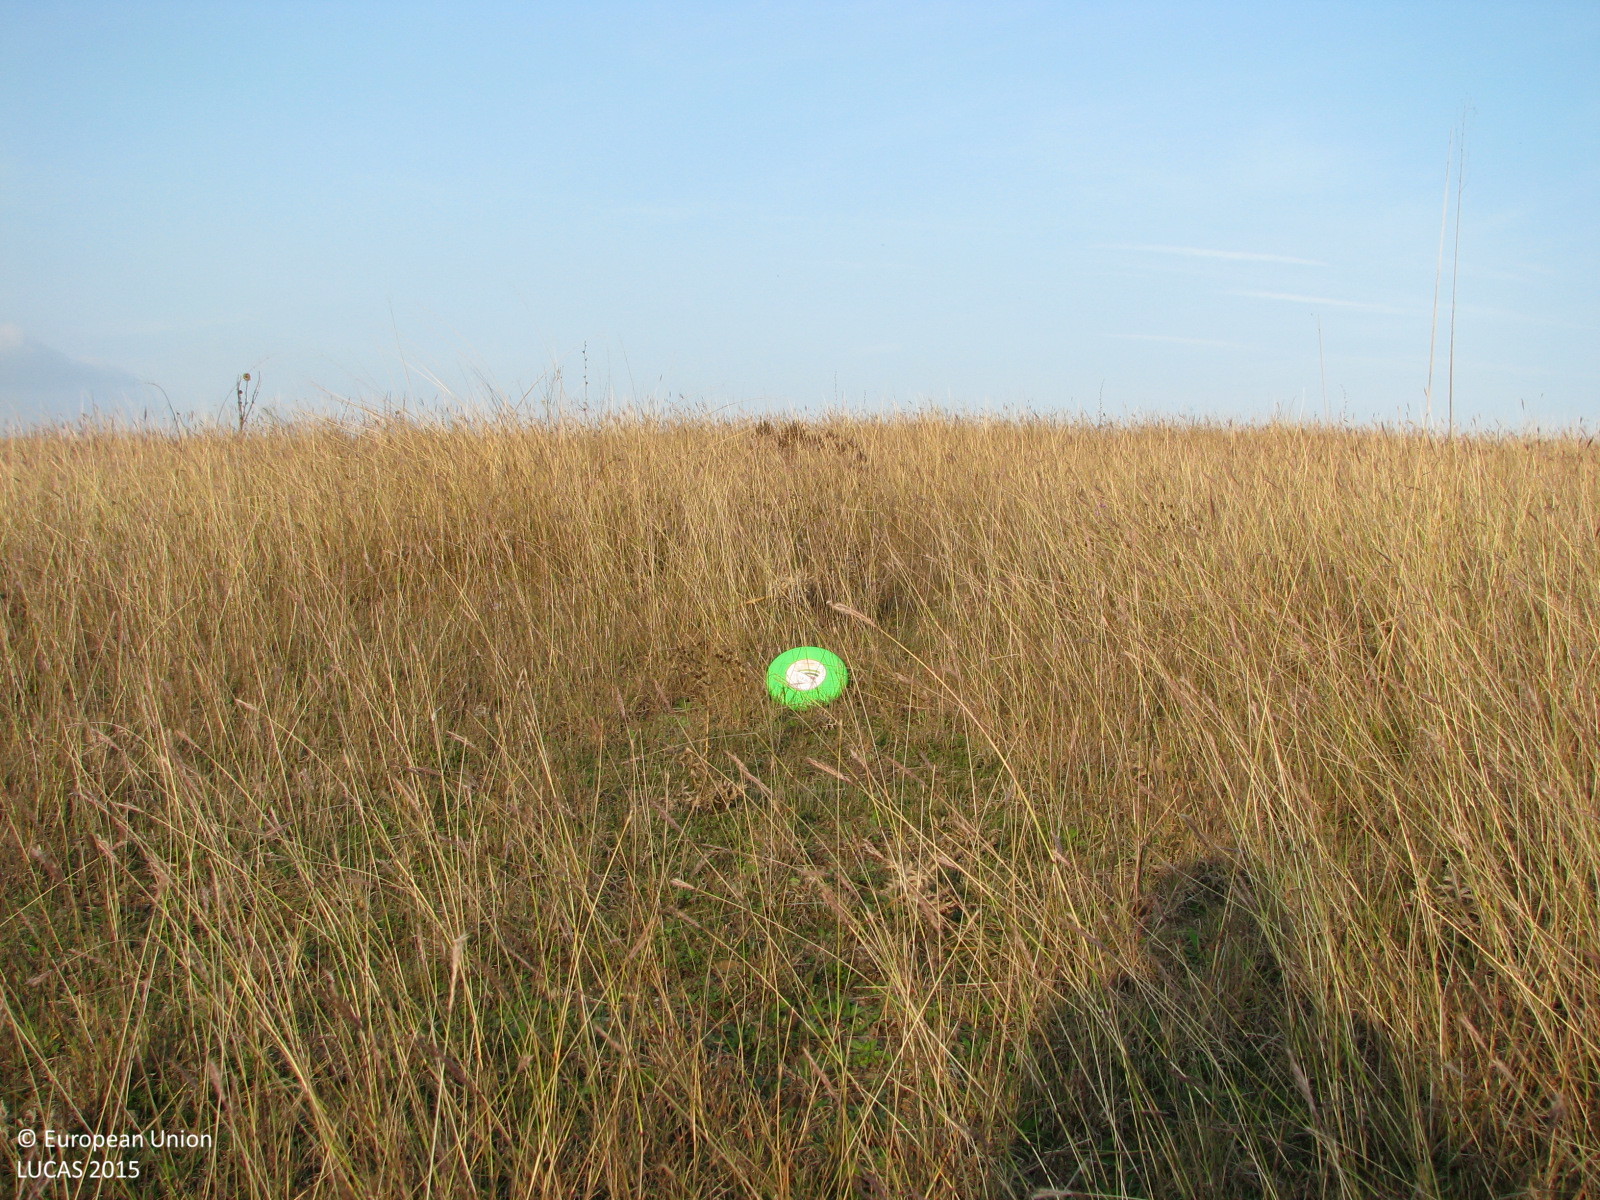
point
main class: Grassland
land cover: Grassland without tree/shrub cover
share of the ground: > 75 %
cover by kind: herbaceous plants 100 %
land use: Agriculture (excluding fallow land and kitchen gardens)
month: October
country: BG
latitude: 42.2954
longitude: 26.4257
